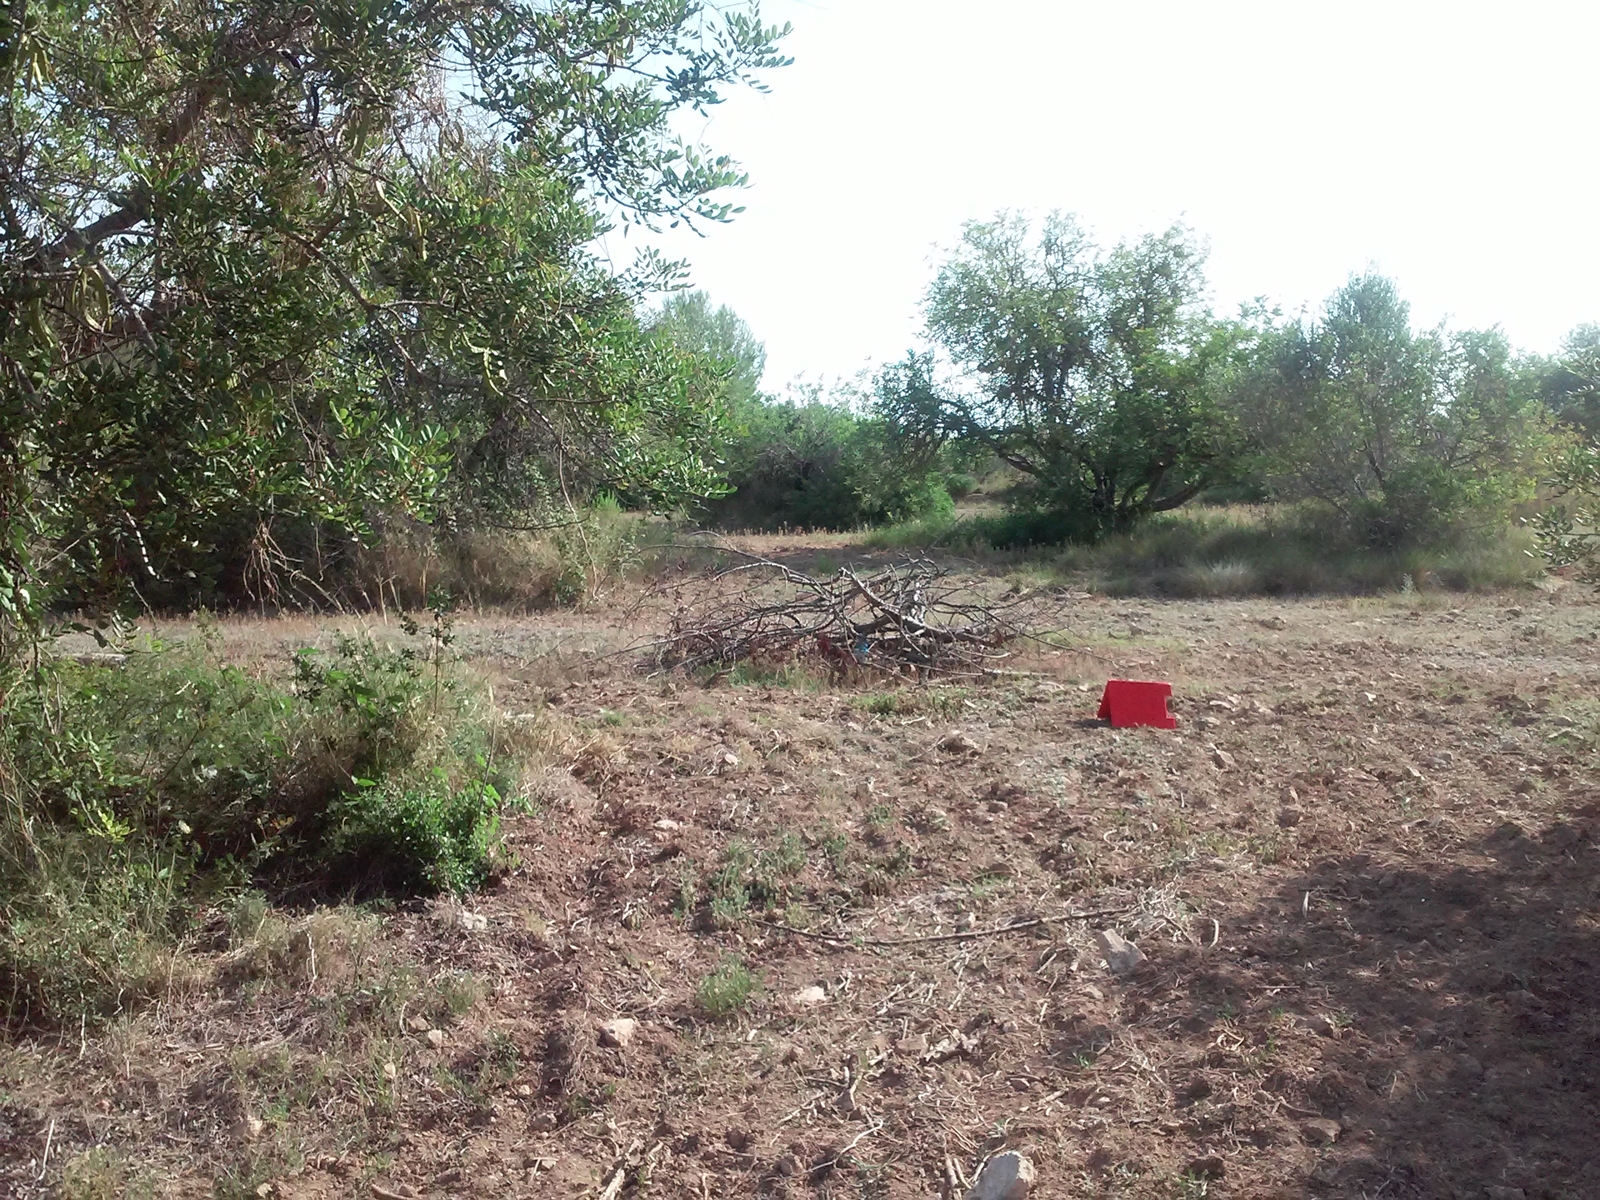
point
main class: Cropland
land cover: Permanent industrial crops
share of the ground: 10 - 25 %
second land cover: Other bare soil
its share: > 75 %
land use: Agriculture (excluding fallow land and kitchen gardens)
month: July
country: ES
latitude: 41.2212
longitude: 1.2496
